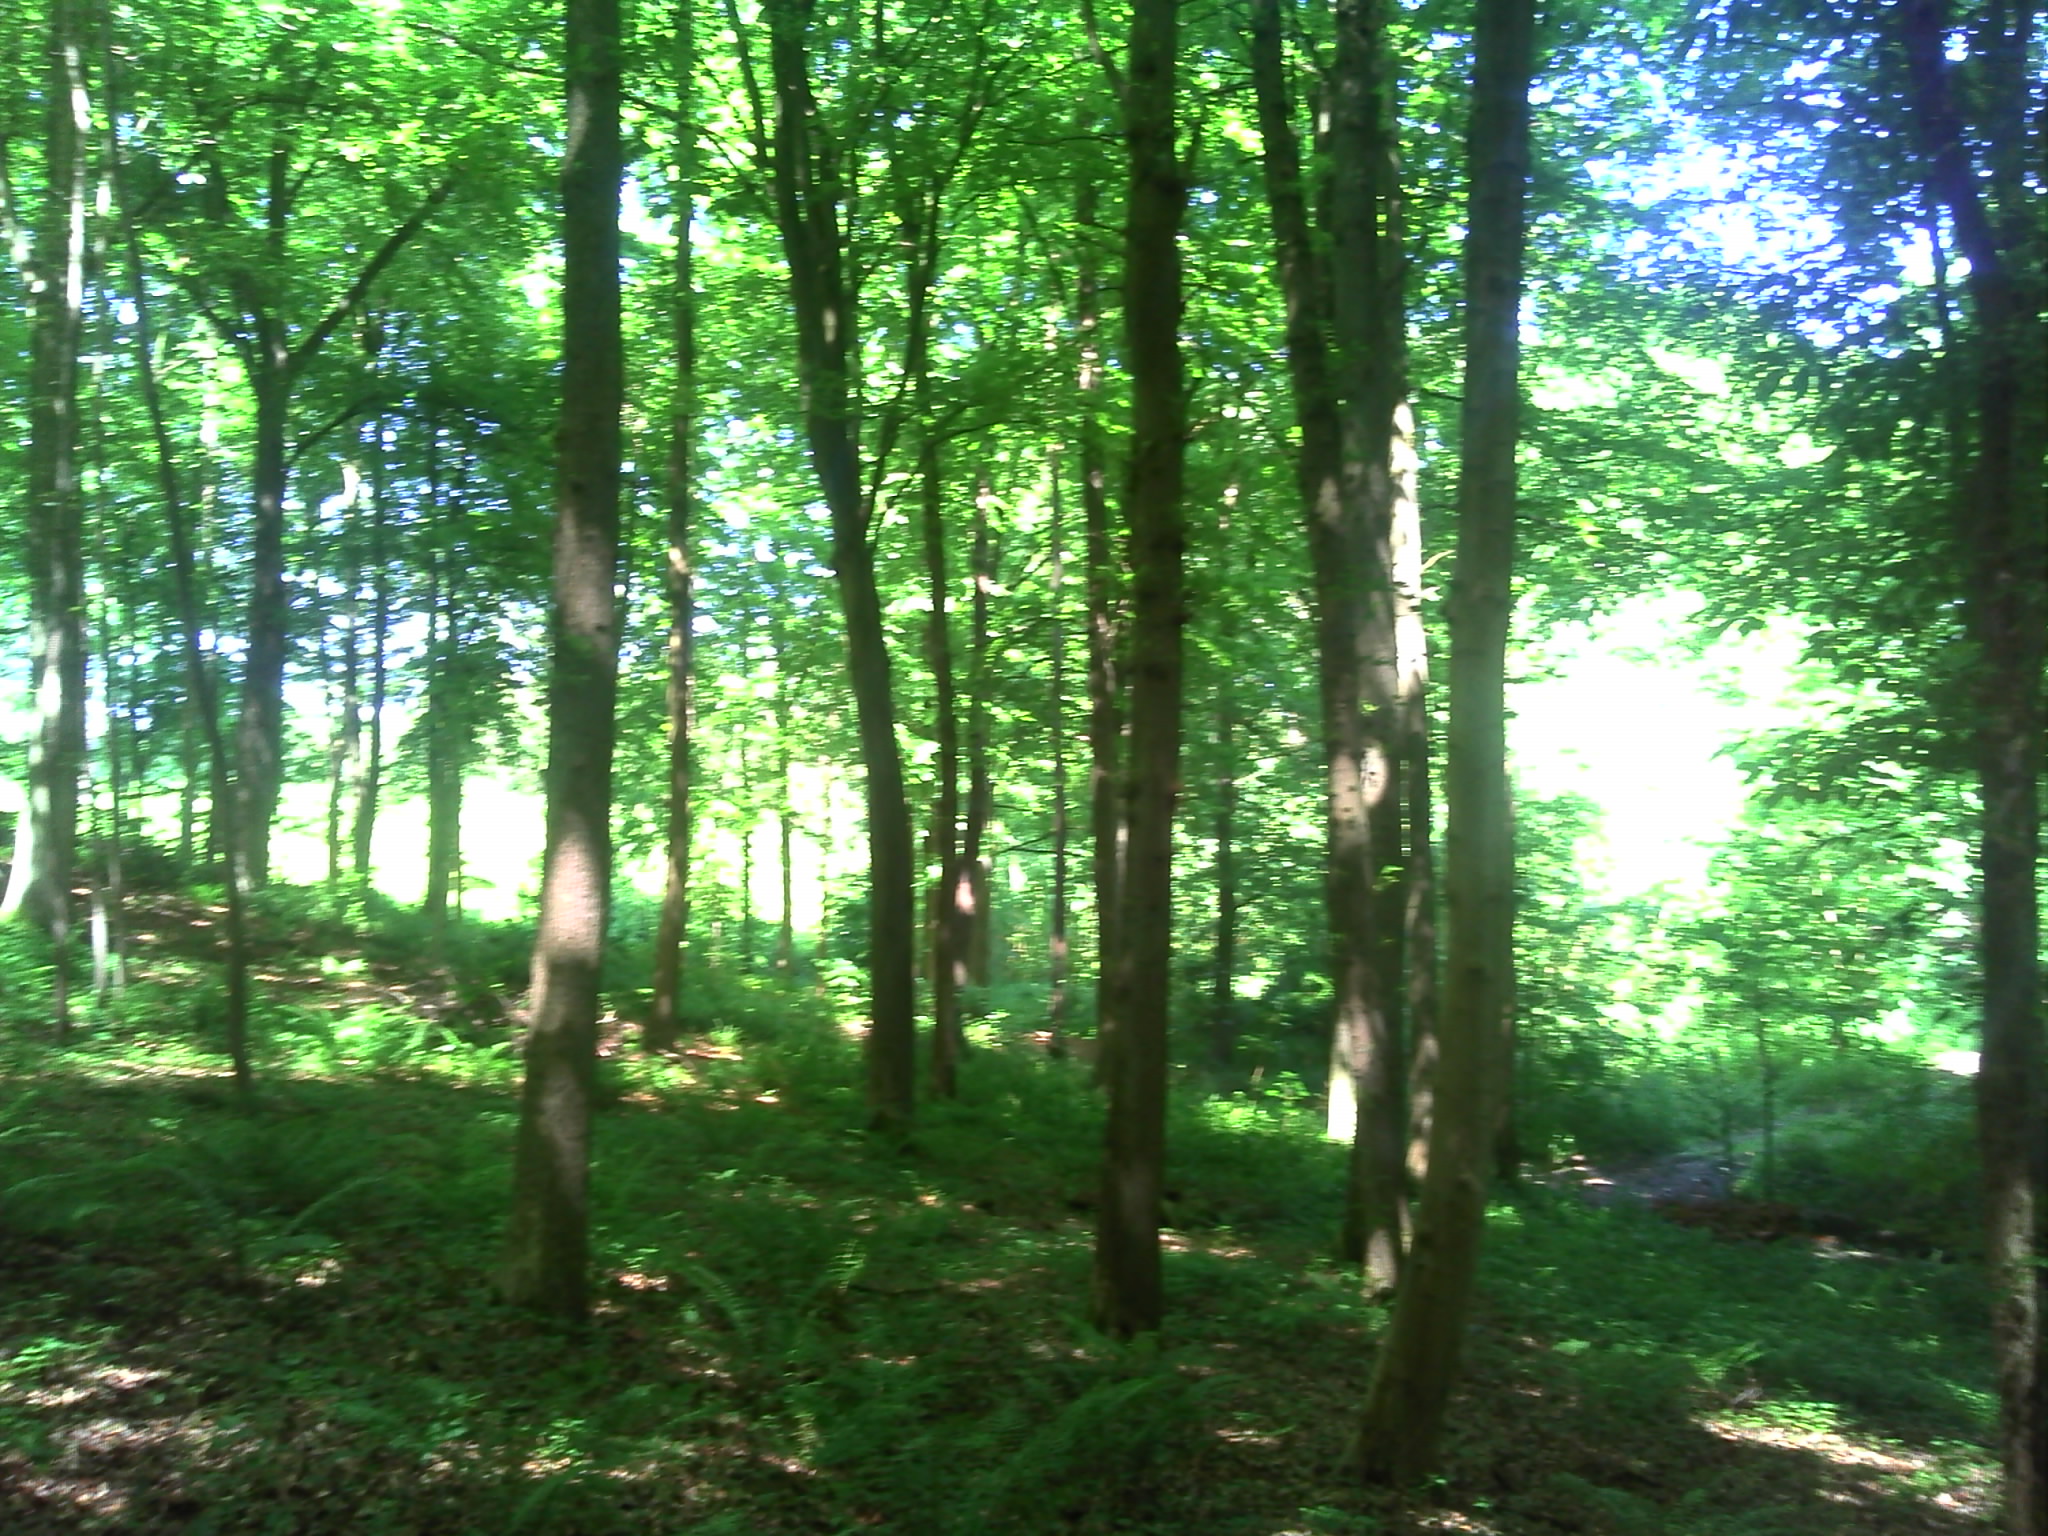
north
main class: Woodland
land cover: Broadleaved woodland
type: acidophilous oak and oak-birch forest
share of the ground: > 75 %
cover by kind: broadleaved forest trees 80 %, herbaceous plants 10 %, coniferous forest trees 5 %, shrubs 5 %
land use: Forestry
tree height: > 5 m
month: June
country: BE
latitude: 50.7370
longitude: 4.5122
